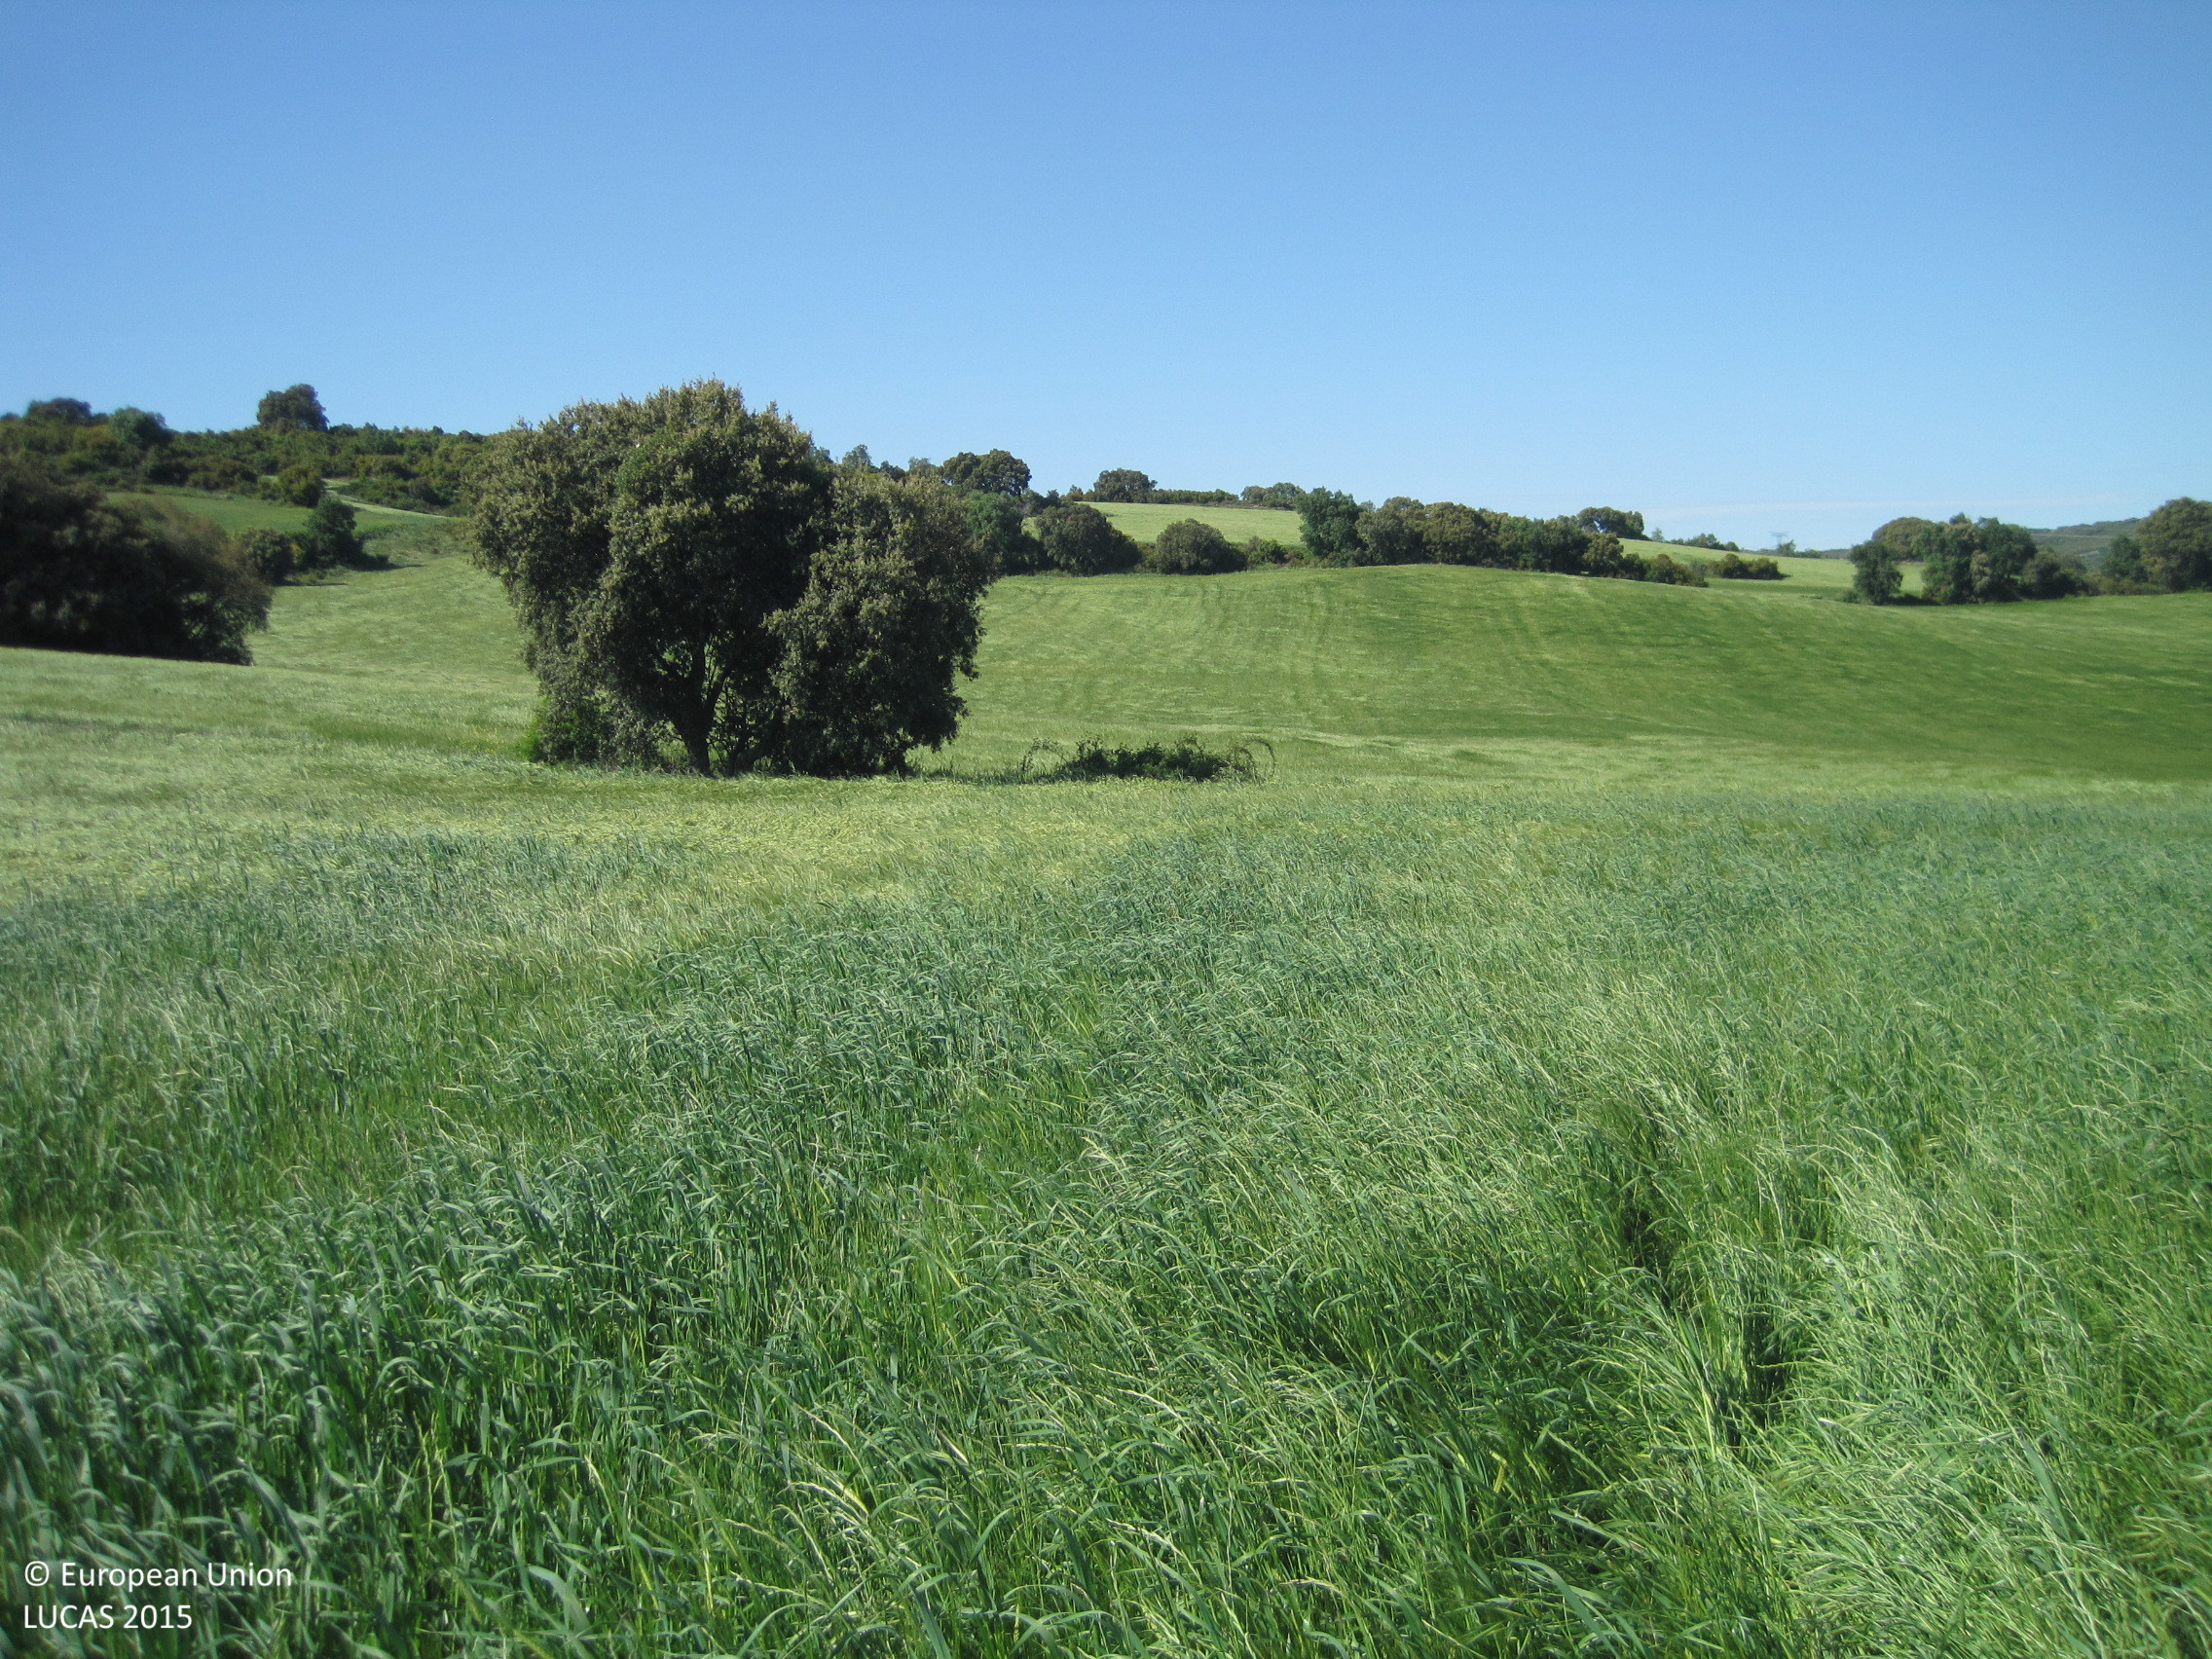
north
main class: Cropland
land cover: Mixed cereals for fodder
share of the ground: > 75 %
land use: Agriculture (excluding fallow land and kitchen gardens)
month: May
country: ES
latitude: 42.5548
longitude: -1.7173
